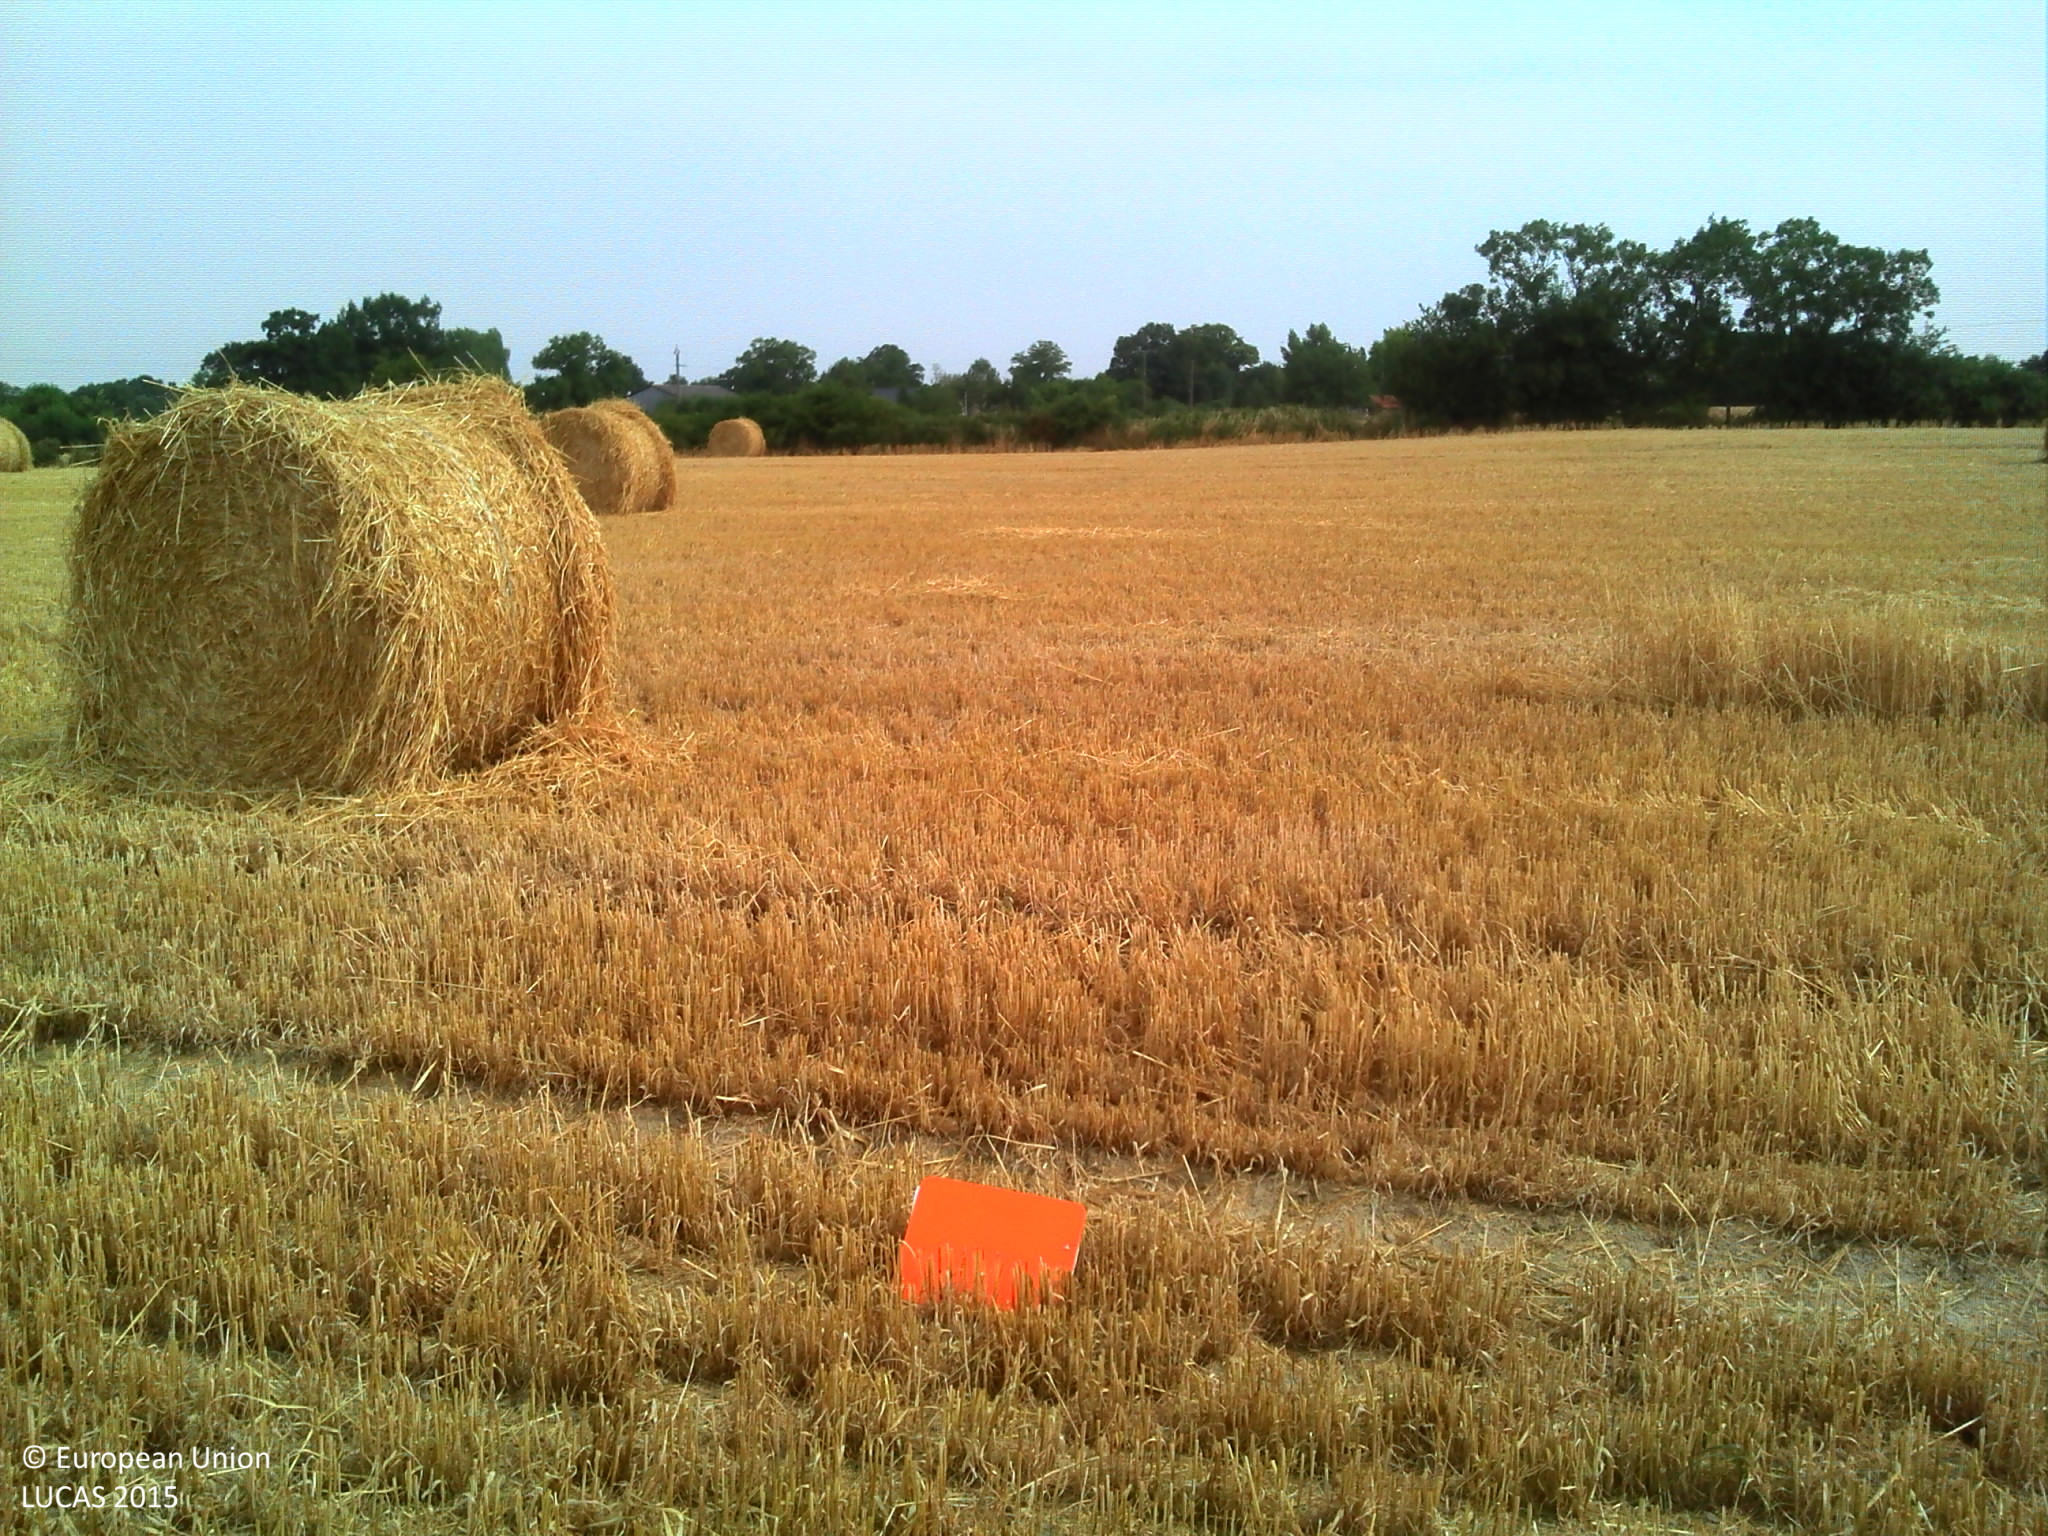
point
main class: Cropland
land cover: Barley
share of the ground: > 75 %
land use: Agriculture (excluding fallow land and kitchen gardens)
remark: Harvested field
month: July
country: FR
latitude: 47.2961
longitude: -1.8022
